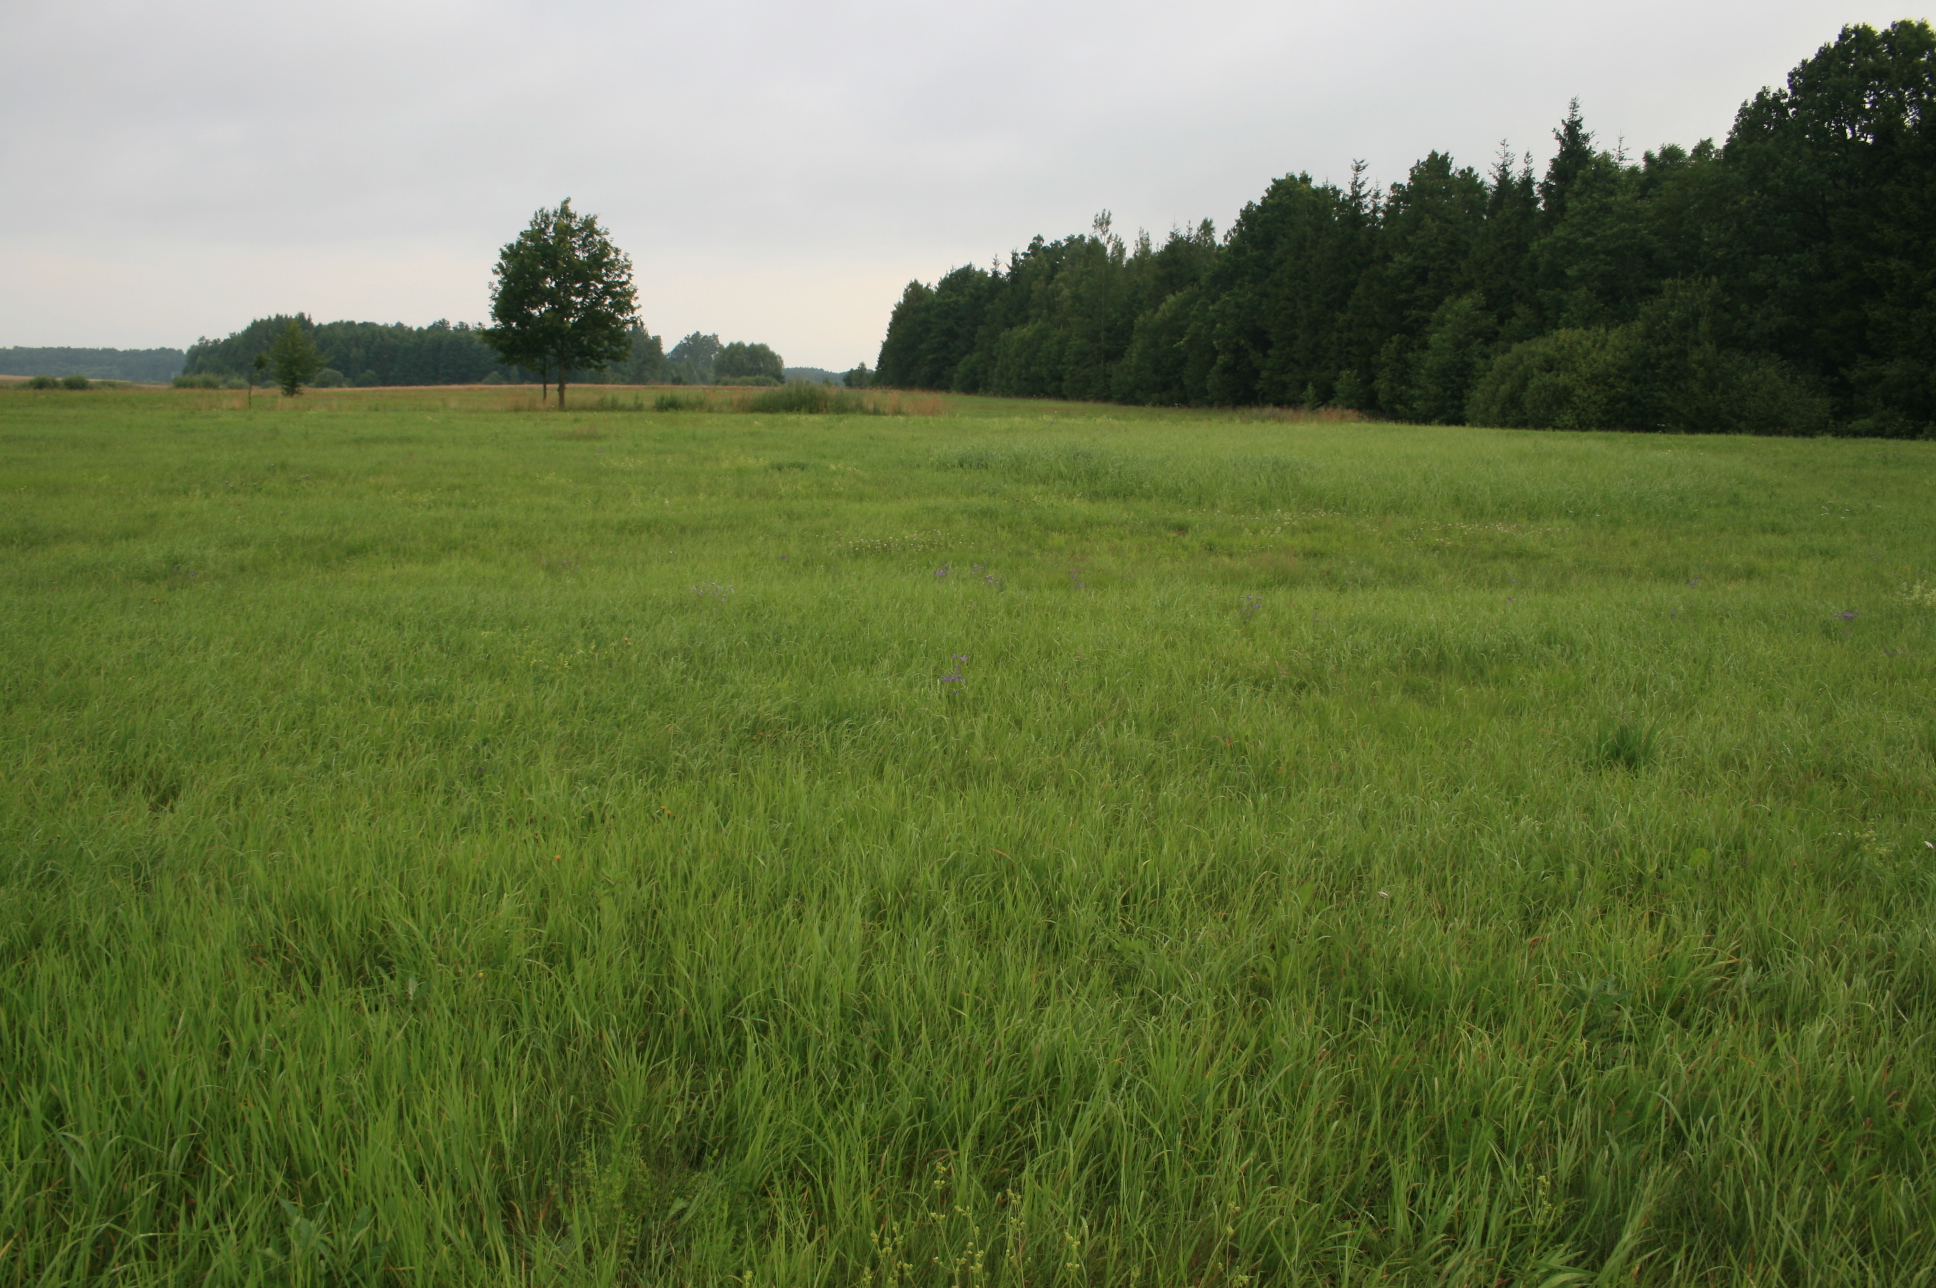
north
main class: Grassland
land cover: Grassland without tree/shrub cover
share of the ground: > 75 %
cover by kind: herbaceous plants 100 %
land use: Agriculture (excluding fallow land and kitchen gardens)
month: July
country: LT
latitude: 55.3707
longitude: 21.7739
